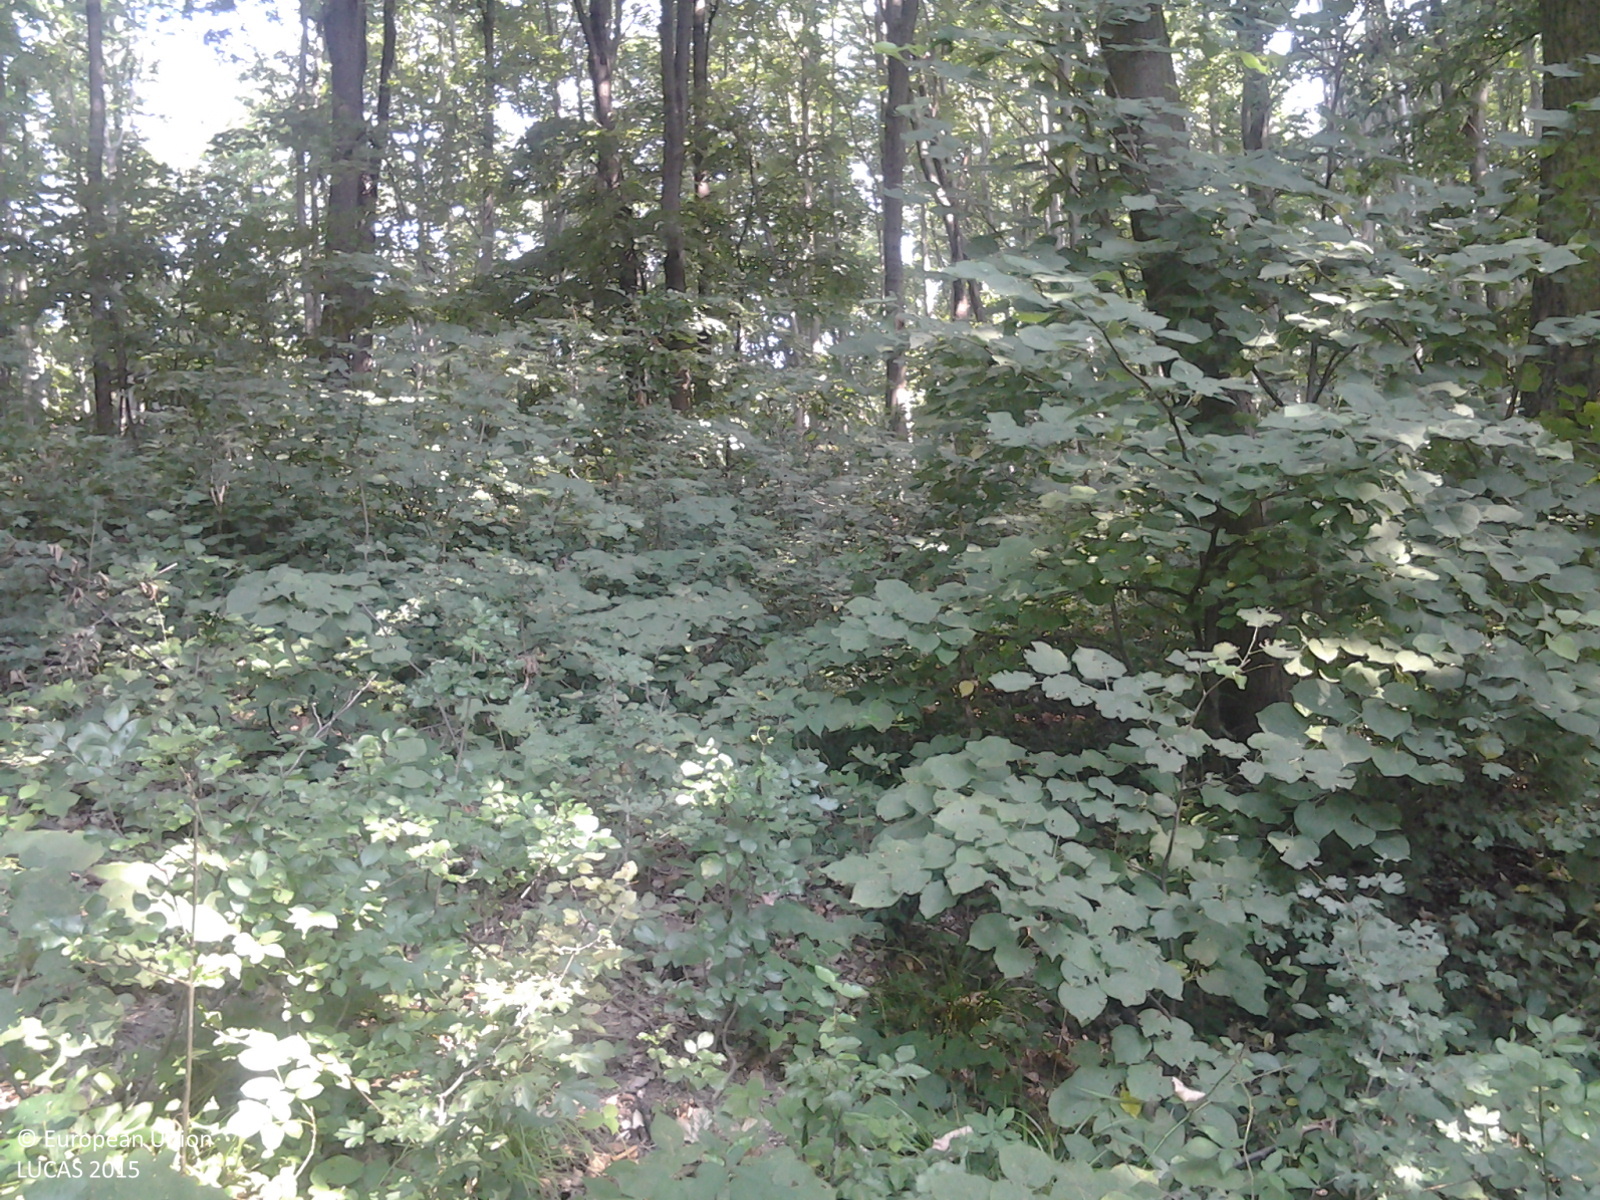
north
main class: Woodland
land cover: Broadleaved woodland
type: mesophytic deciduous forest
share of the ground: > 75 %
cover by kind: broadleaved forest trees 75 %, shrubs 25 %
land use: Forestry
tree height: > 5 m
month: August
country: HU
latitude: 46.2545
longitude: 17.6974
